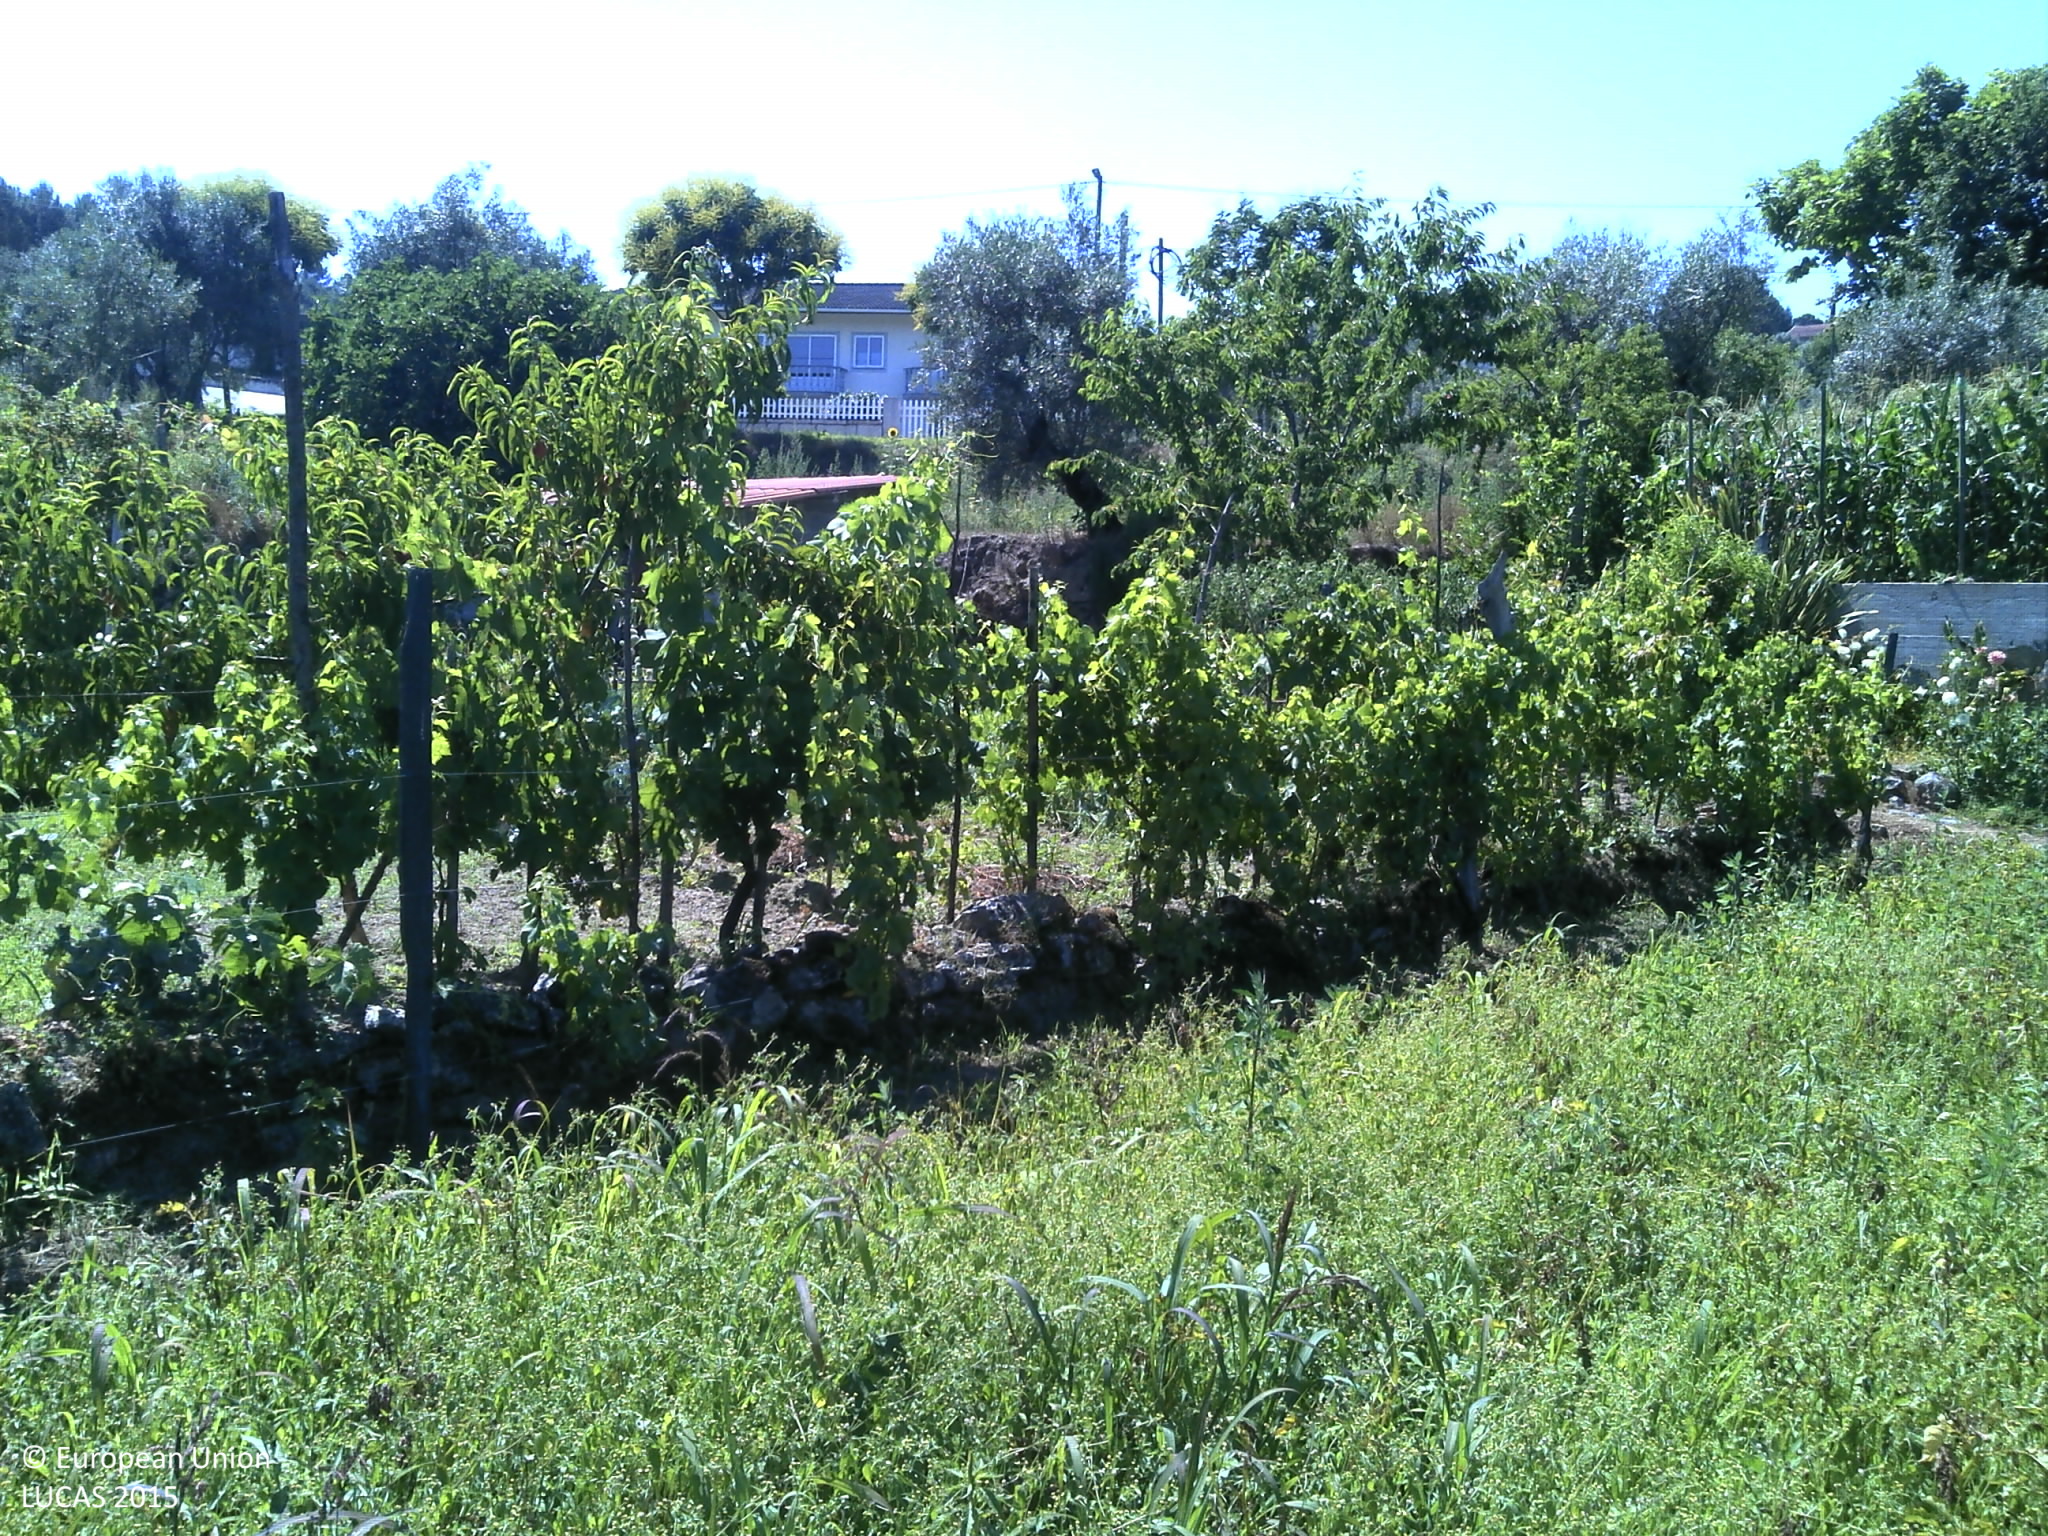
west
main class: Grassland
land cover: Spontaneously vegetated surfaces
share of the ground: > 75 %
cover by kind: herbaceous plants 90 %, unconsolidated bare surface 10 %
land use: Fallow land
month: June
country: PT
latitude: 40.6042
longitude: -7.9824
